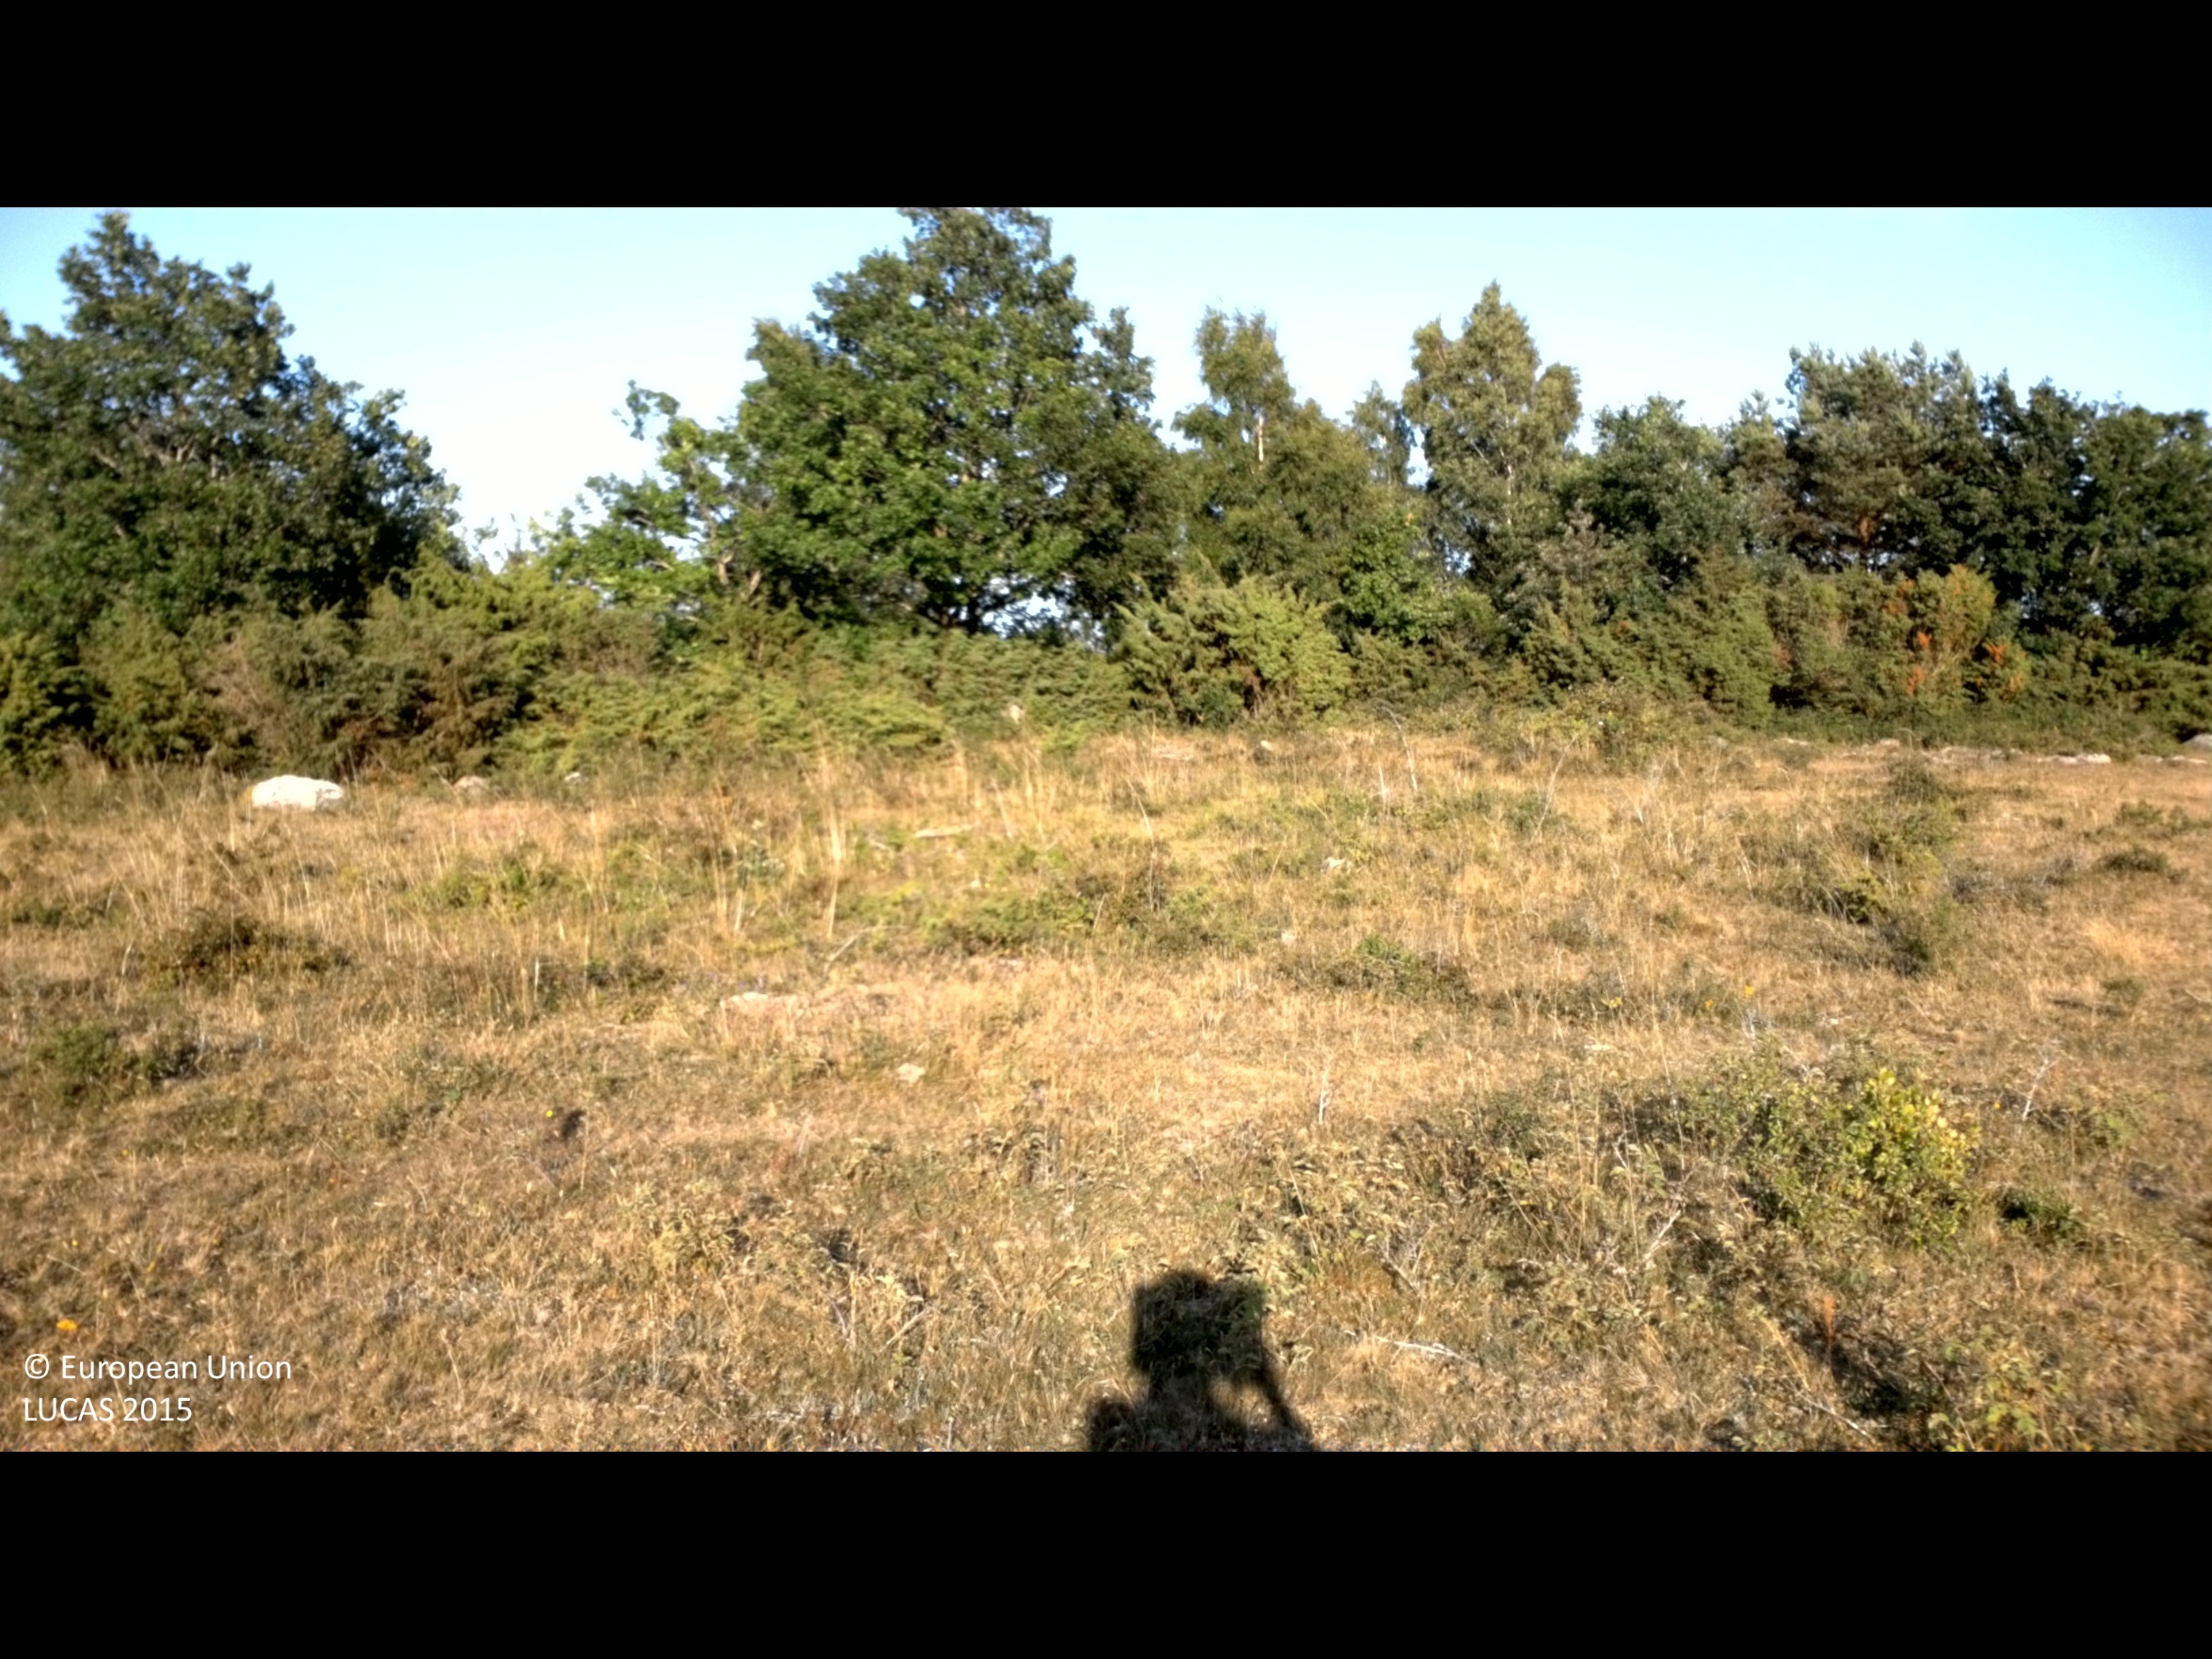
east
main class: Grassland
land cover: Grassland with sparse tree/shrub cover
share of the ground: > 75 %
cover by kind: herbaceous plants 90 %, broadleaved forest trees 5 %, shrubs 5 %
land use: Agriculture (excluding fallow land and kitchen gardens)
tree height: < 5 m
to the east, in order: Grassland with sparse tree/shrub cover; Broadleaved woodland; Shrubland with sparse tree cover; Grassland with sparse tree/shrub cover
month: July
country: SE
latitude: 56.3157
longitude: 16.4202
